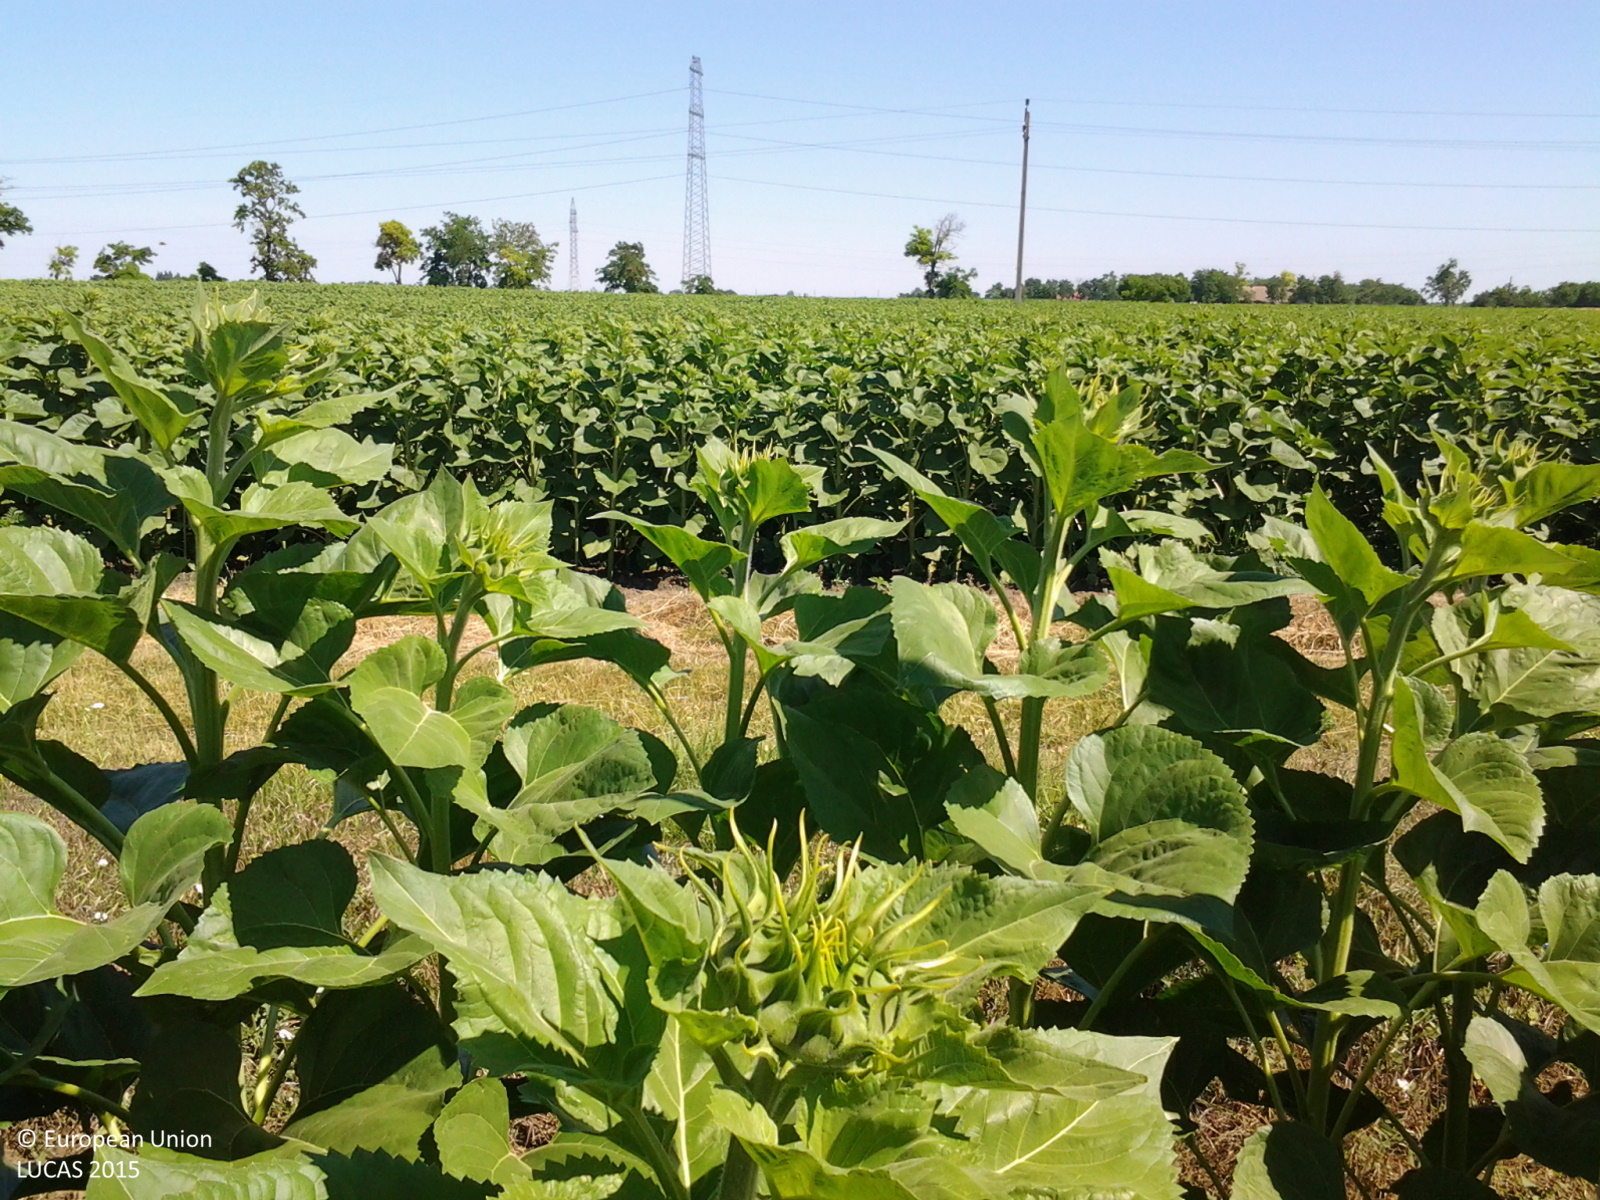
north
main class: Cropland
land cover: Sunflower
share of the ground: > 75 %
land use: Agriculture (excluding fallow land and kitchen gardens)
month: June
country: HU
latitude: 46.5997
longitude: 20.6414
